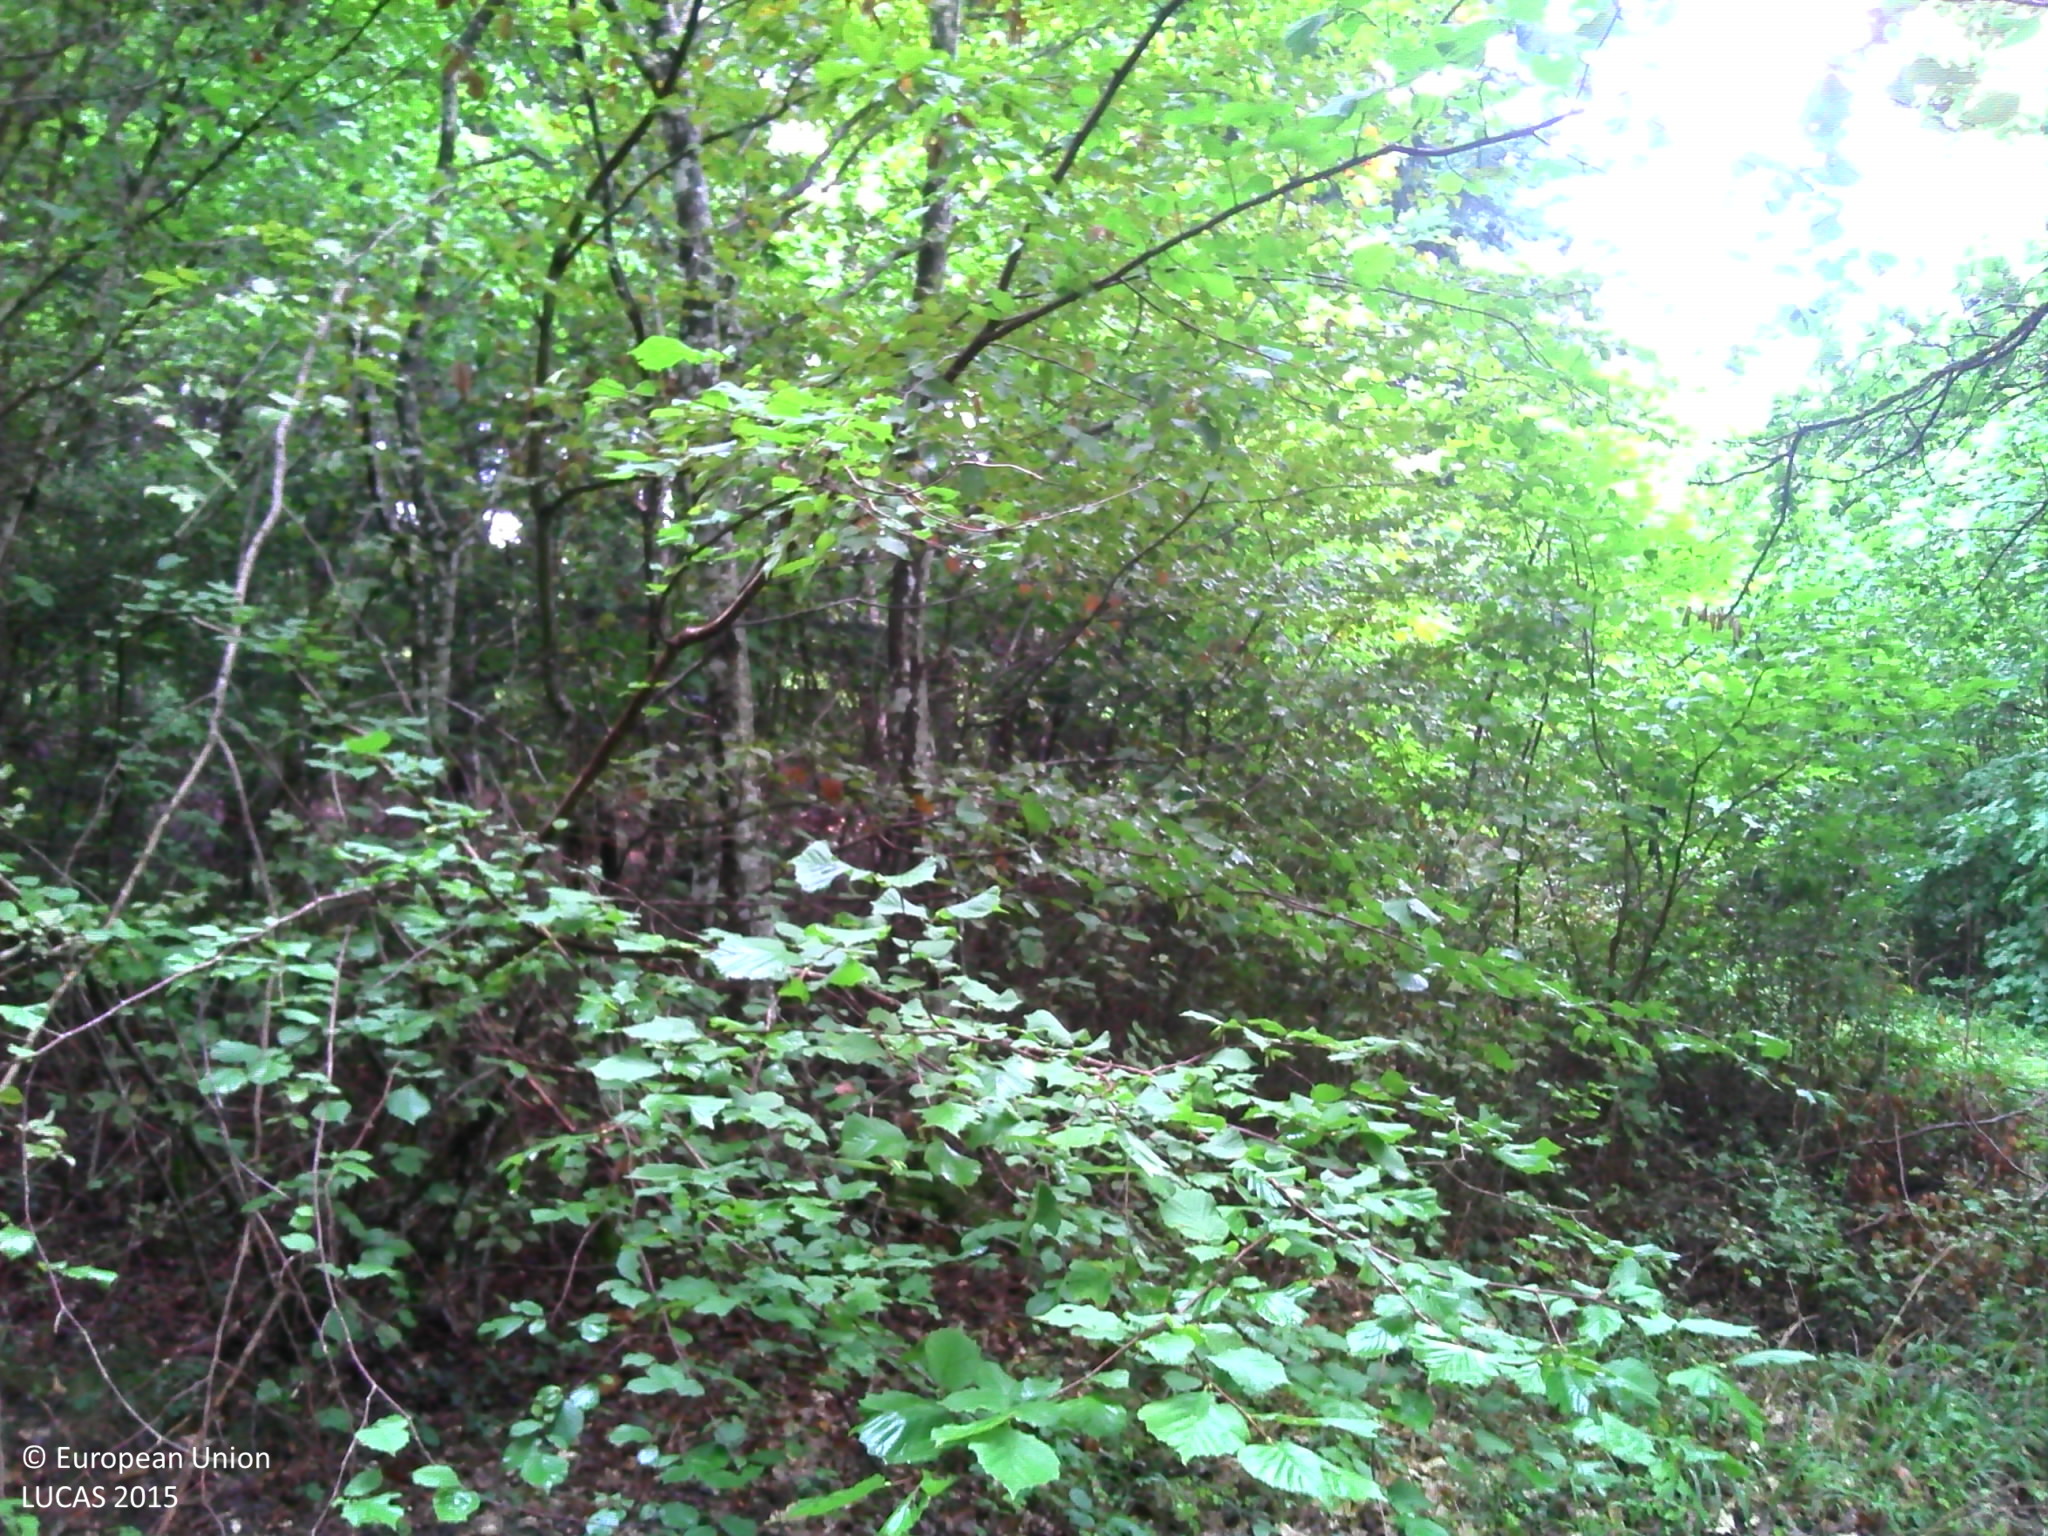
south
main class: Woodland
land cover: Other mixed woodland
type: exotic forest
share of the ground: > 75 %
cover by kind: coniferous forest trees 40 %, broadleaved forest trees 40 %, shrubs 10 %, herbaceous plants 10 %
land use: Forestry
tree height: > 5 m
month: September
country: FR
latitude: 47.1613
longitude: 4.7636
